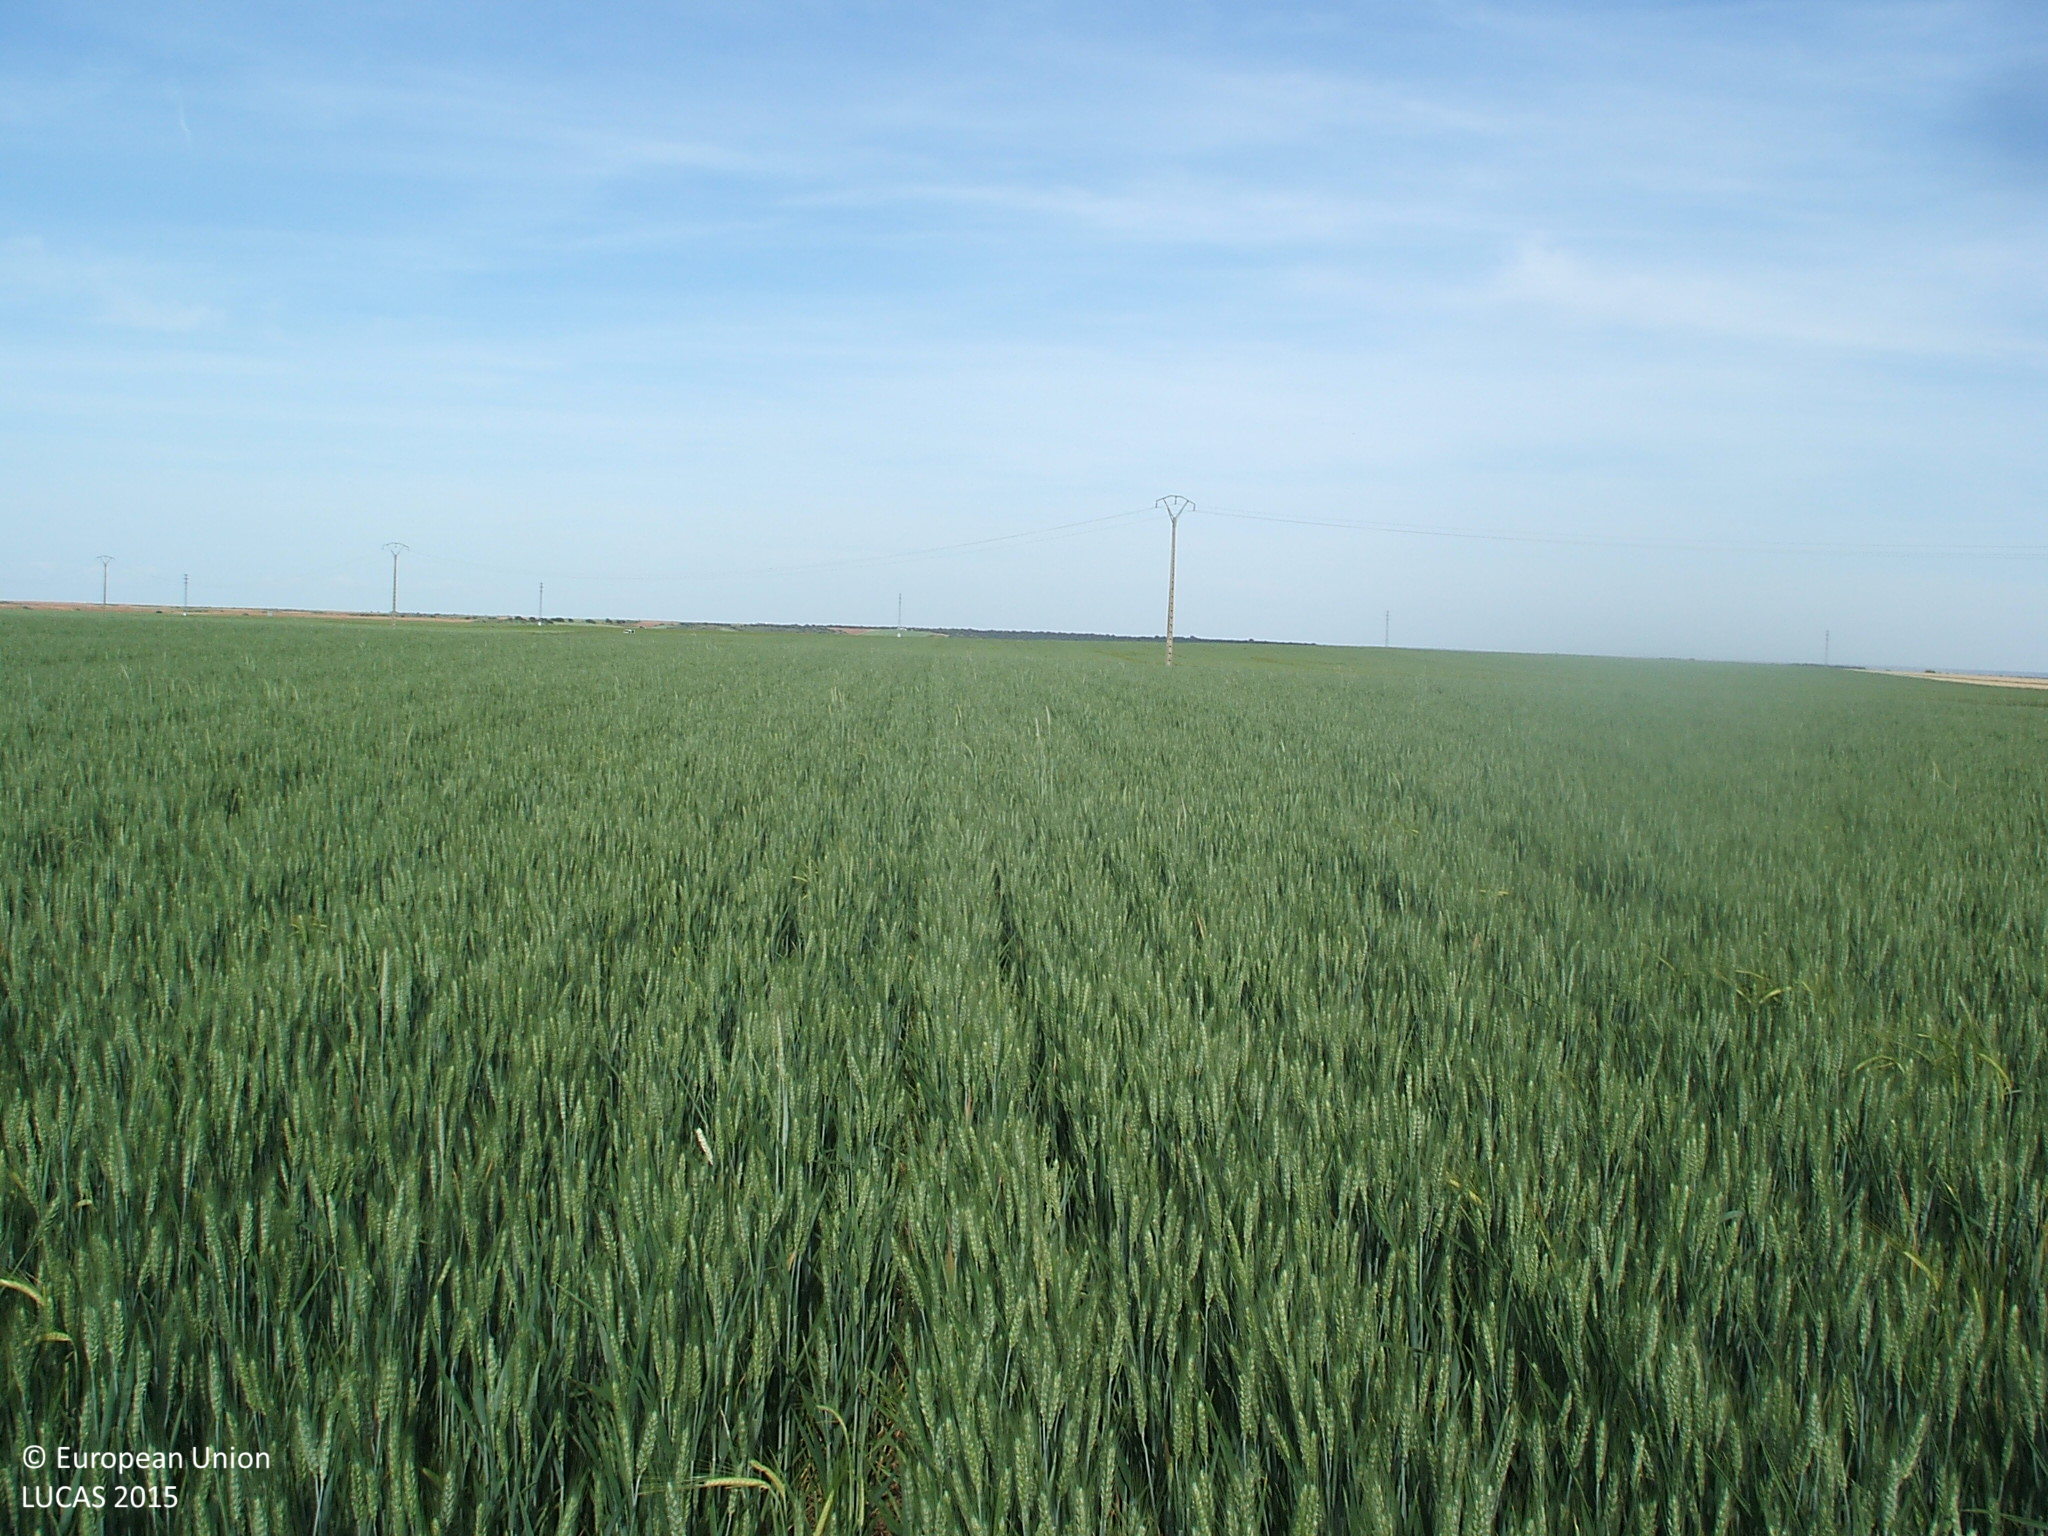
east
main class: Cropland
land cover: Common wheat
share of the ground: > 75 %
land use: Agriculture (excluding fallow land and kitchen gardens)
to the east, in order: Common wheat; Electric lines; Common wheat; Tracks; Common wheat
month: May
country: ES
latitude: 40.7308
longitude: -3.4295
